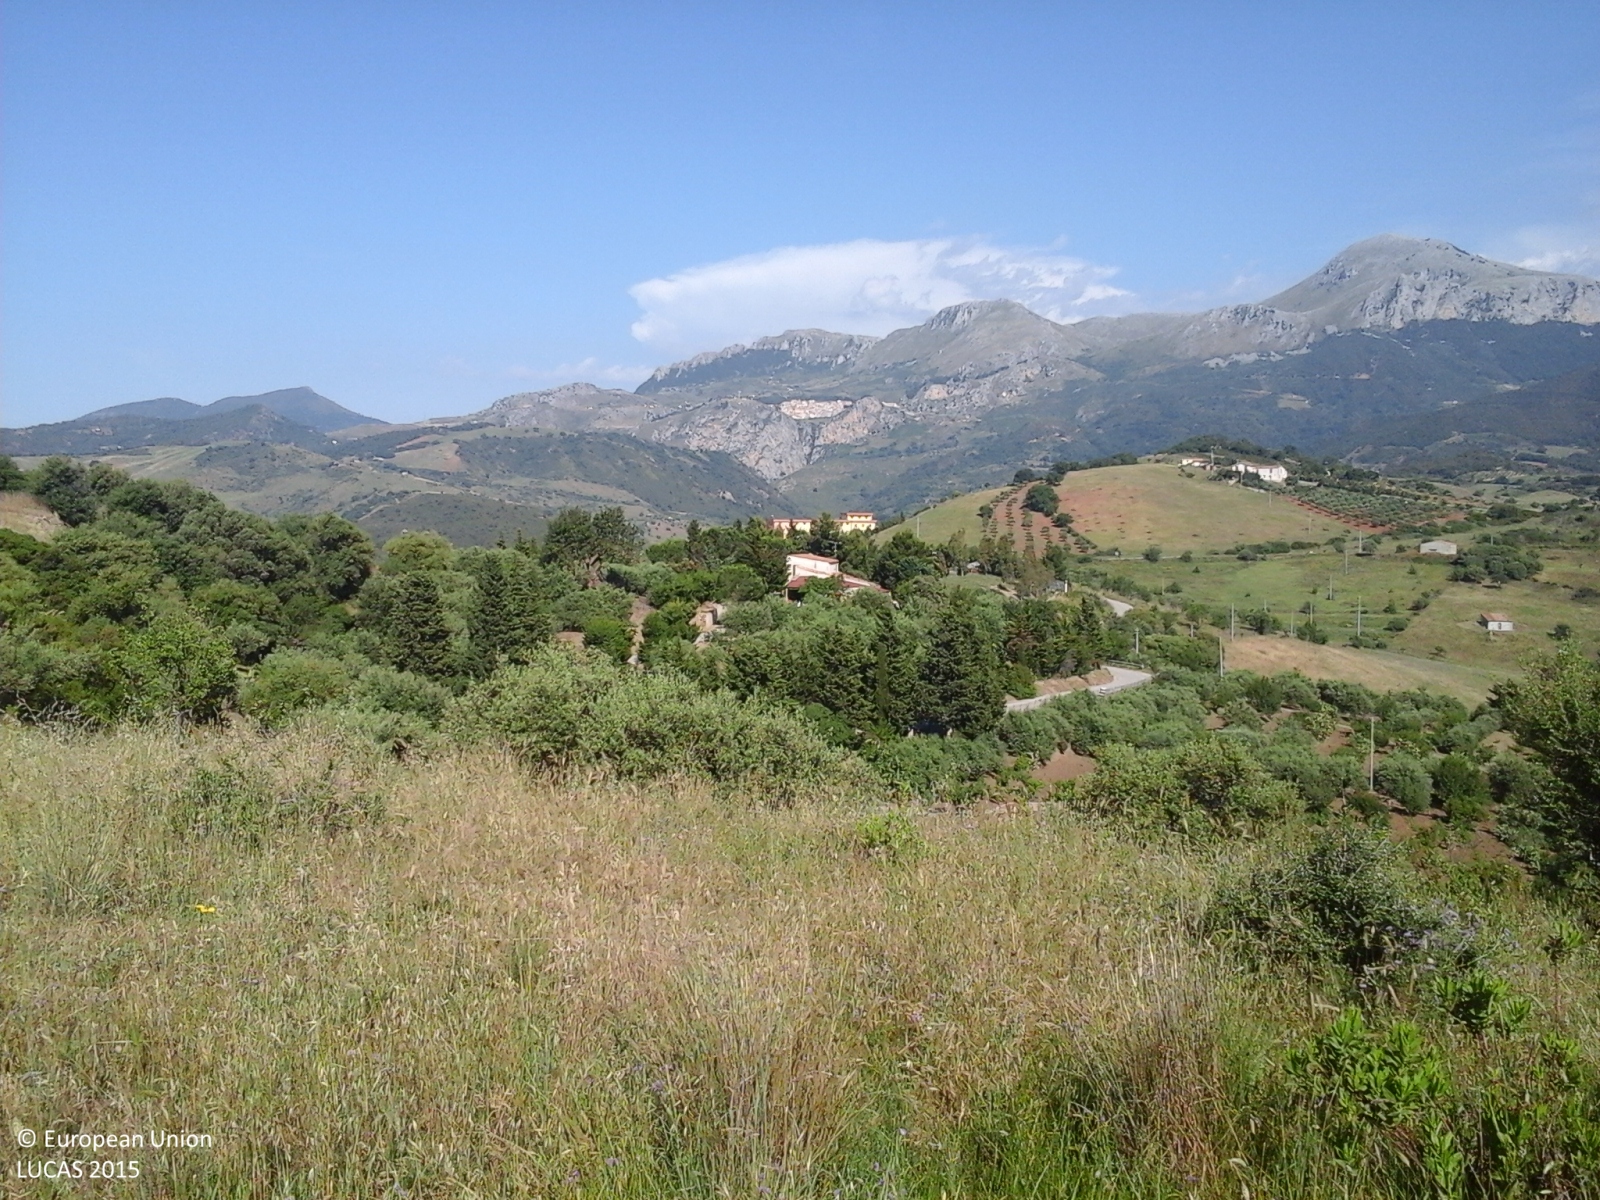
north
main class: Grassland
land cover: Grassland without tree/shrub cover
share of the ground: > 75 %
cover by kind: herbaceous plants 100 %
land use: Agriculture (excluding fallow land and kitchen gardens)
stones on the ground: 10 - 25 %
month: June
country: IT
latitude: 37.9755
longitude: 13.9228
